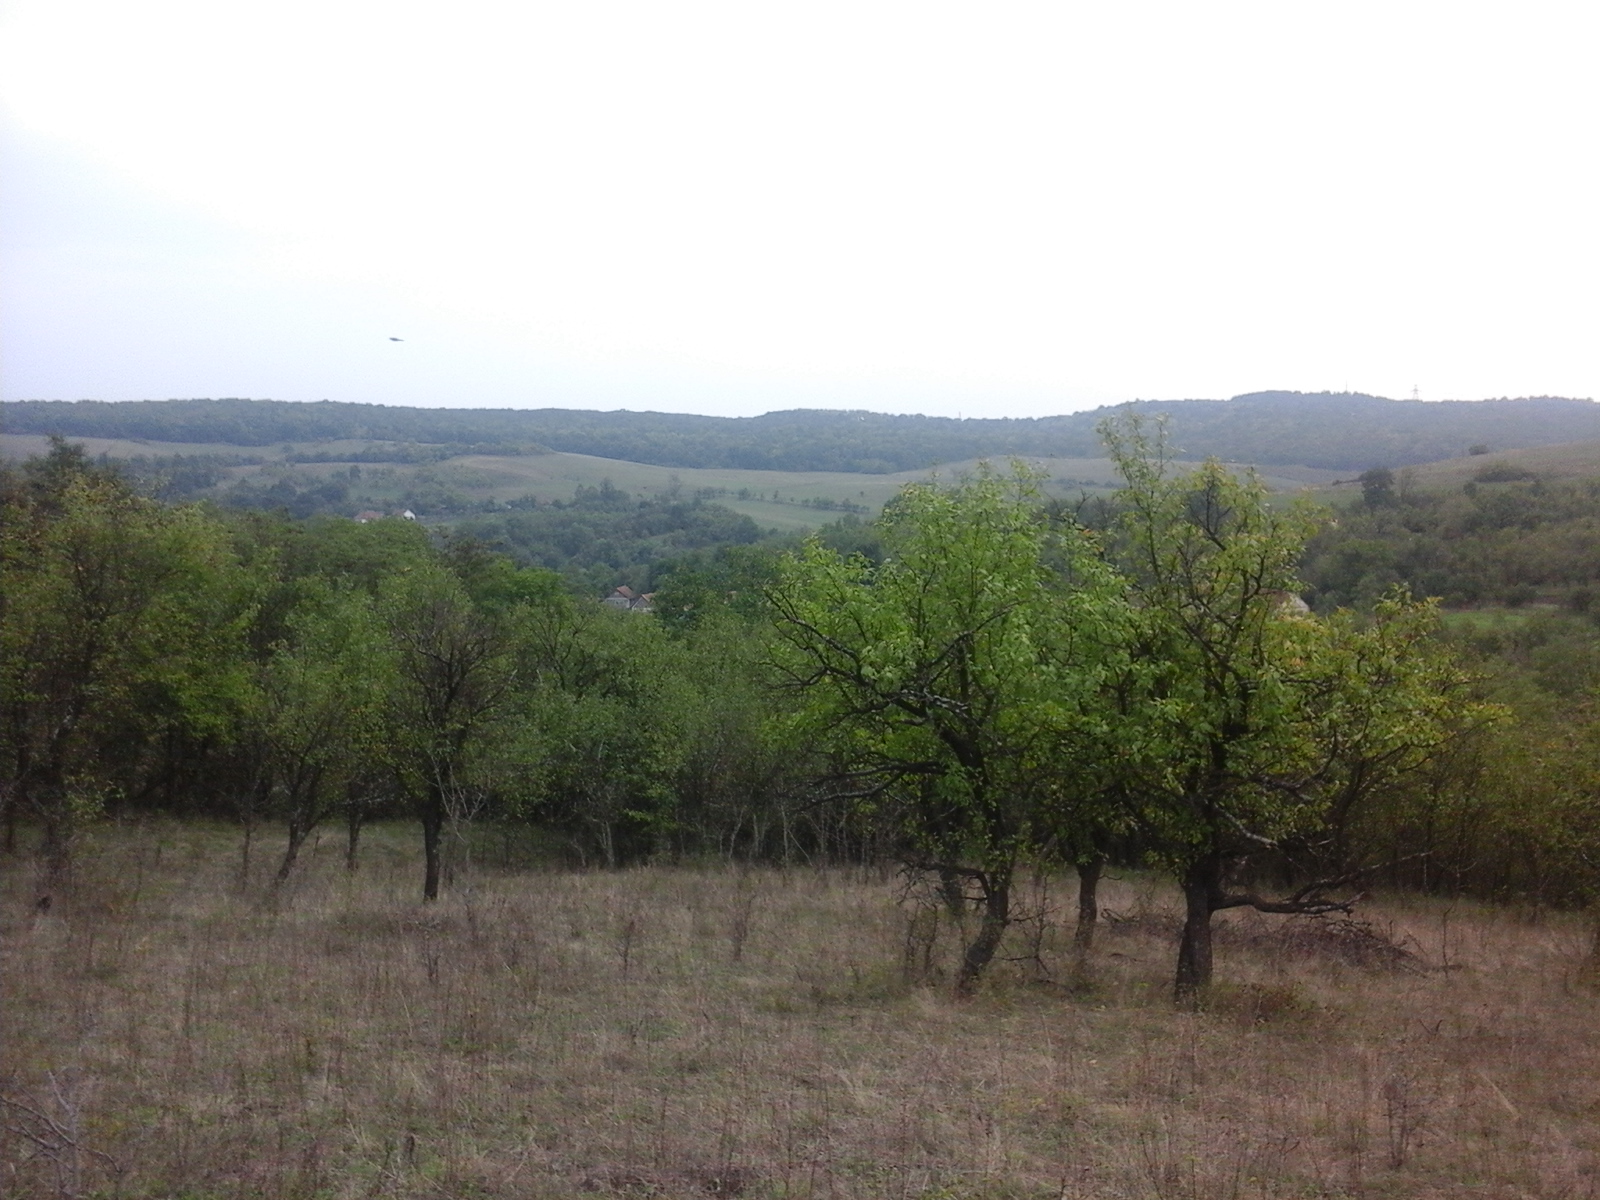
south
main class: Cropland
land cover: Other fruit trees and berries
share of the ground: > 75 %
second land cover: Grassland without tree/shrub cover
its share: > 75 %
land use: Agriculture (excluding fallow land and kitchen gardens)
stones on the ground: < 10 %
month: September
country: RO
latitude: 45.7576
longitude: 22.9749
